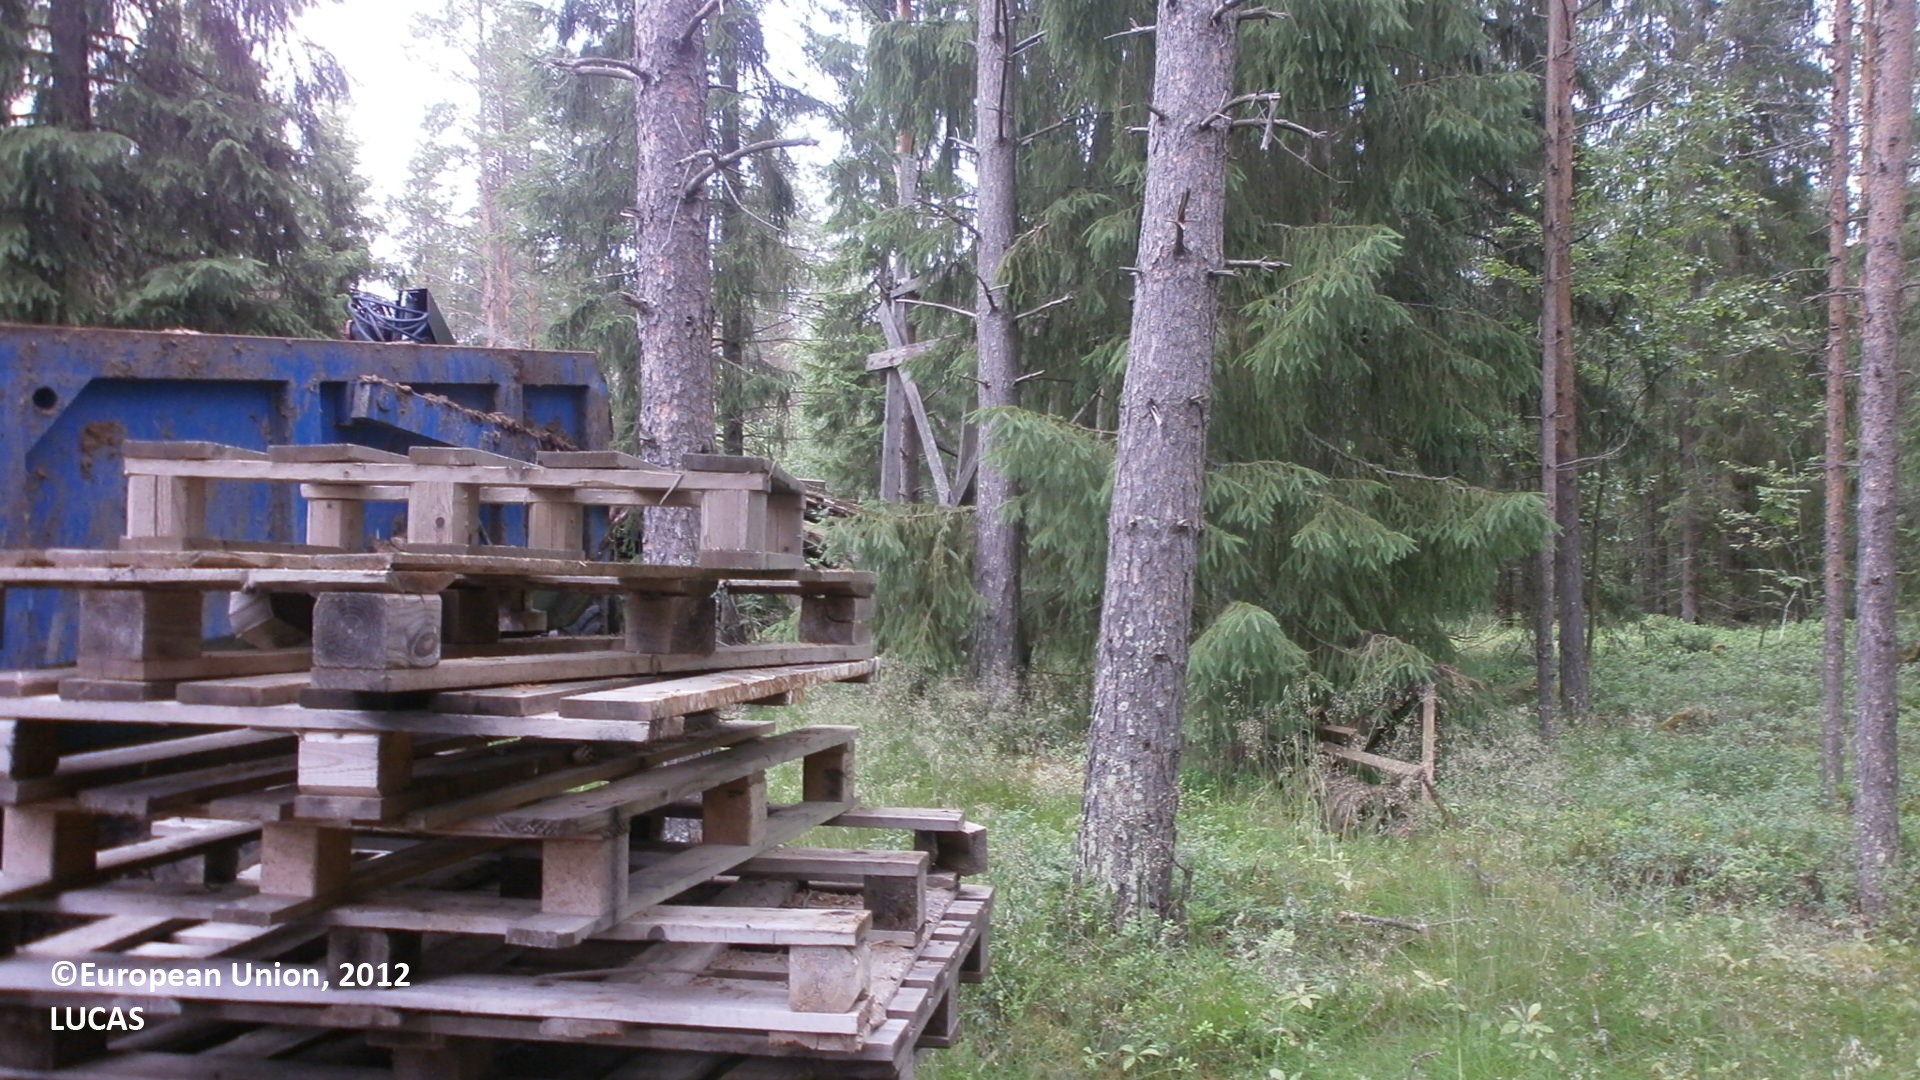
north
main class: Woodland
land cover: Pine dominated coniferous woodland
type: boreal forest
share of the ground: 50 - 75 %
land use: Forestry
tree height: > 5 m
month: July
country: FI
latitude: 64.3435
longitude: 24.4145
